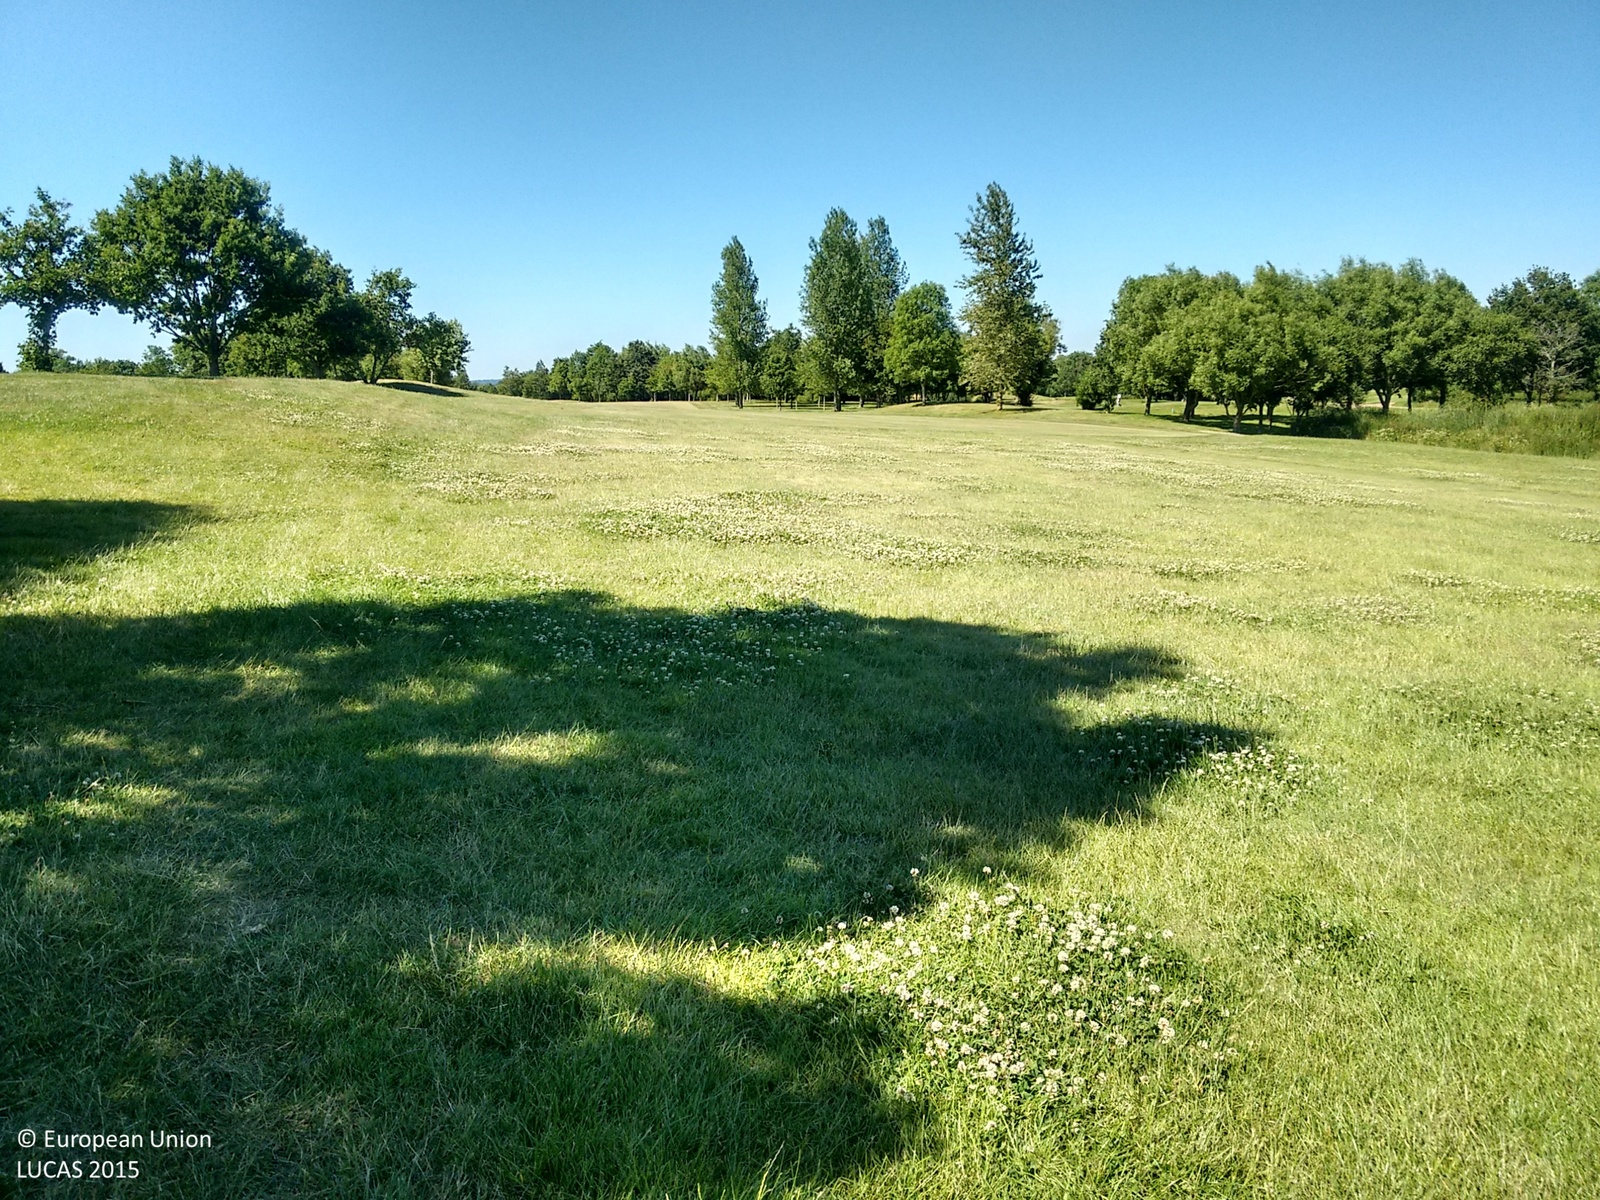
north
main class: Grassland
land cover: Grassland without tree/shrub cover
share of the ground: > 75 %
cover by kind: herbaceous plants 100 %
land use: Sport
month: June
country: GB
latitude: 50.9214
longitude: -0.2063
